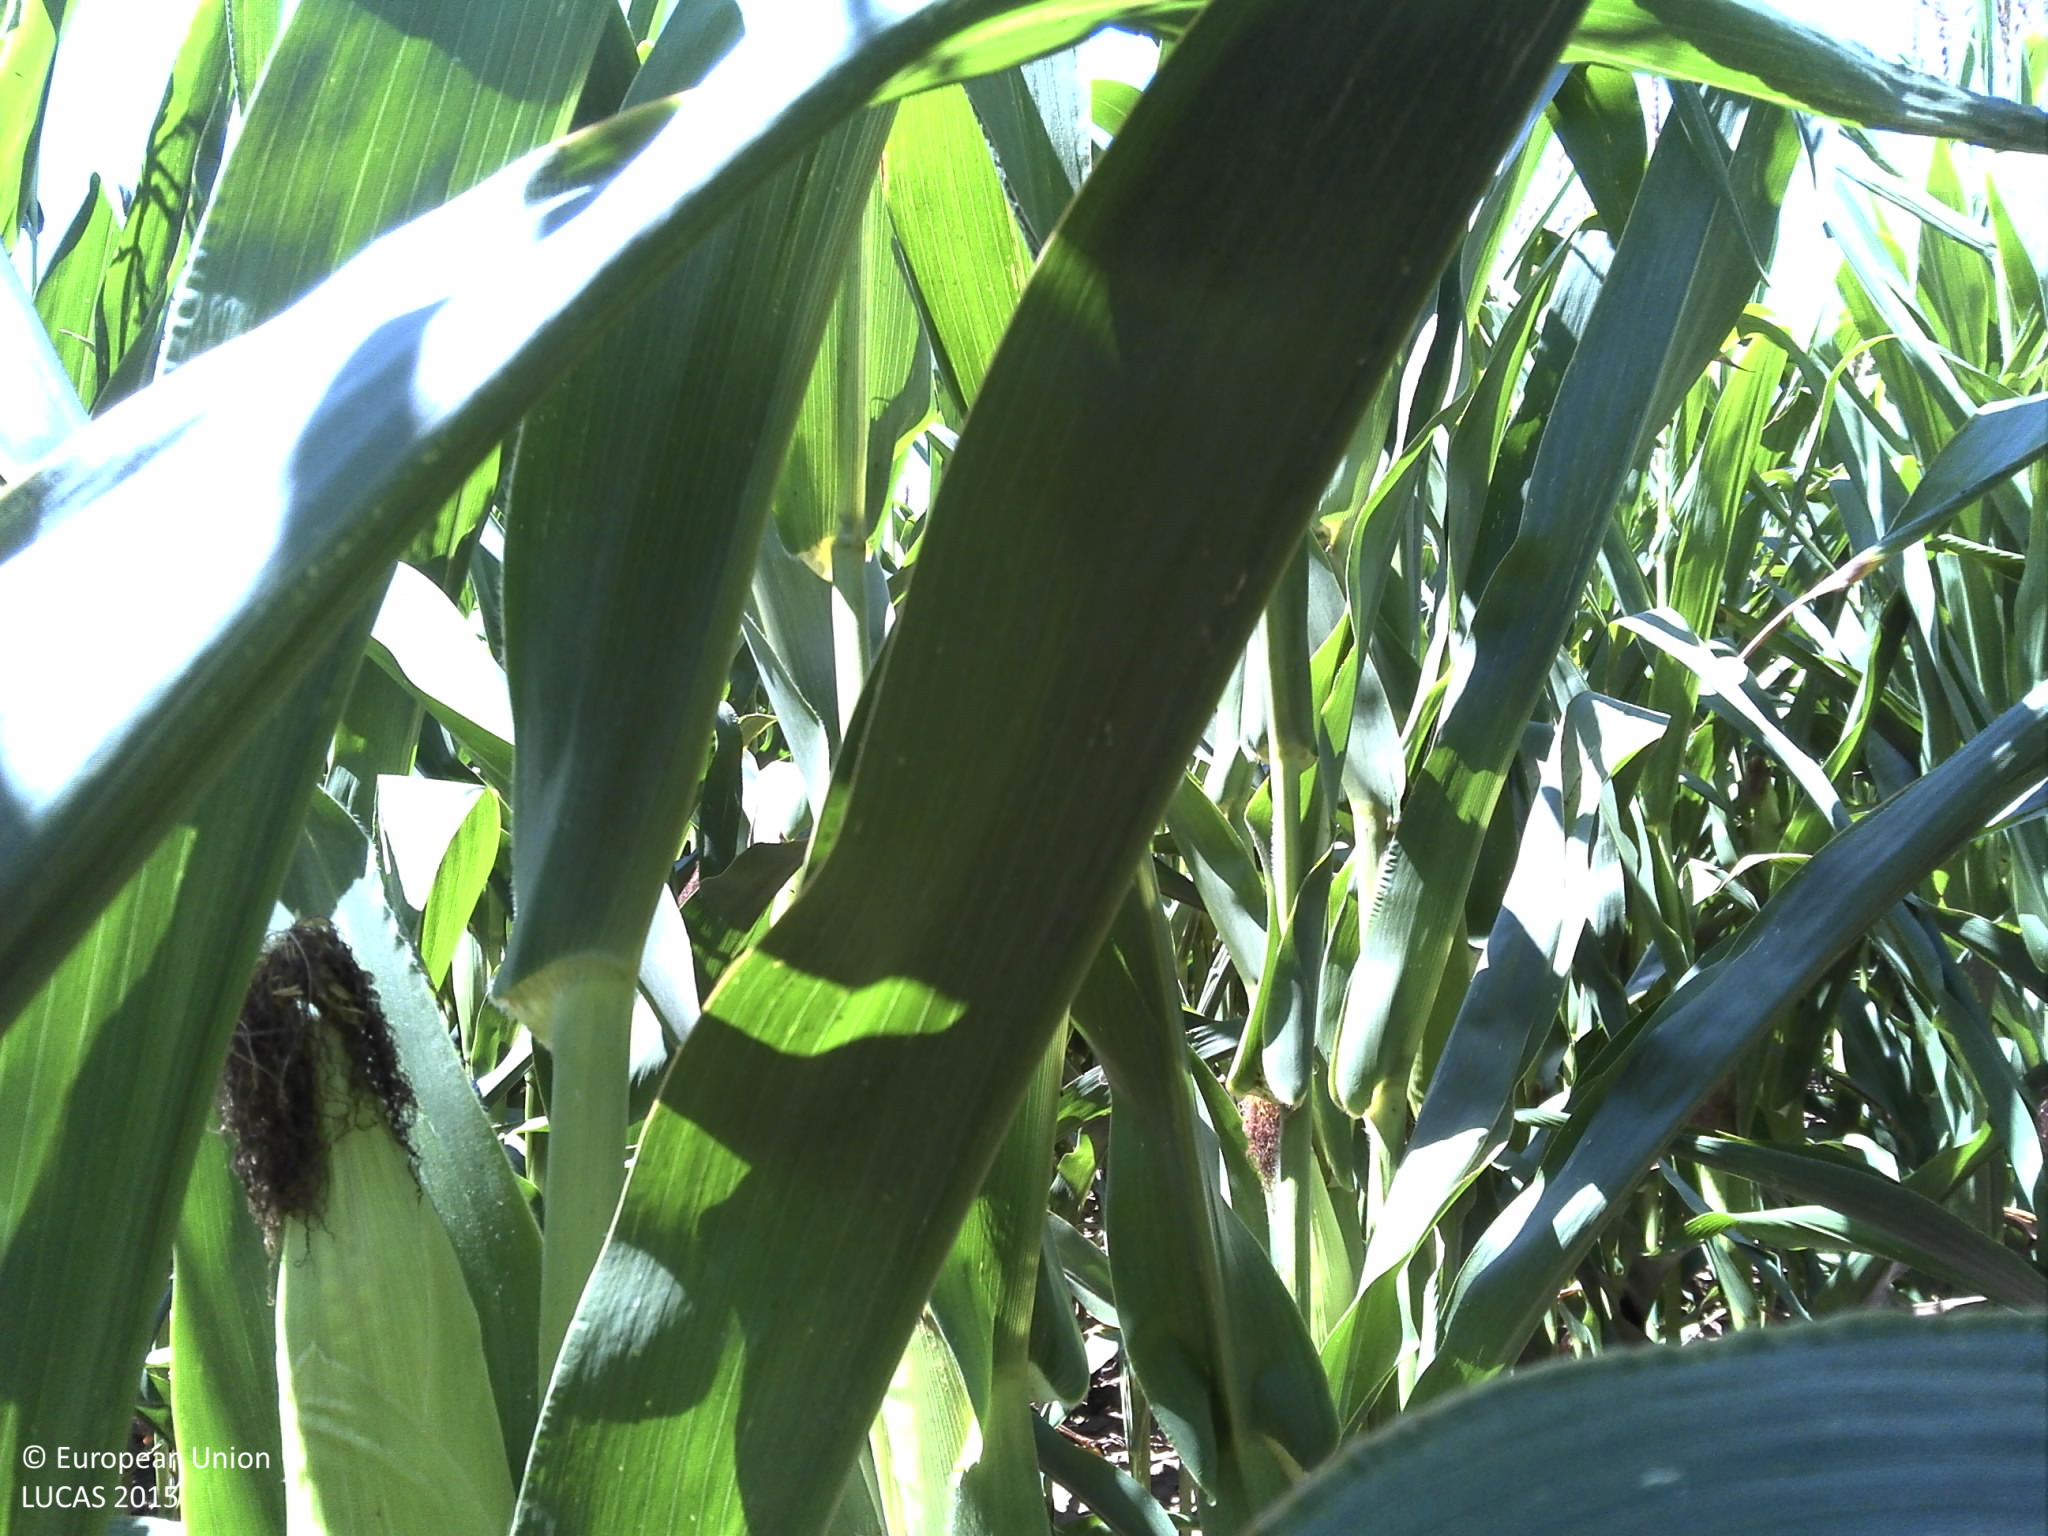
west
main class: Cropland
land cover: Maize
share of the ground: > 75 %
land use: Agriculture (excluding fallow land and kitchen gardens)
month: July
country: FR
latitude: 45.4841
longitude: -1.0685
